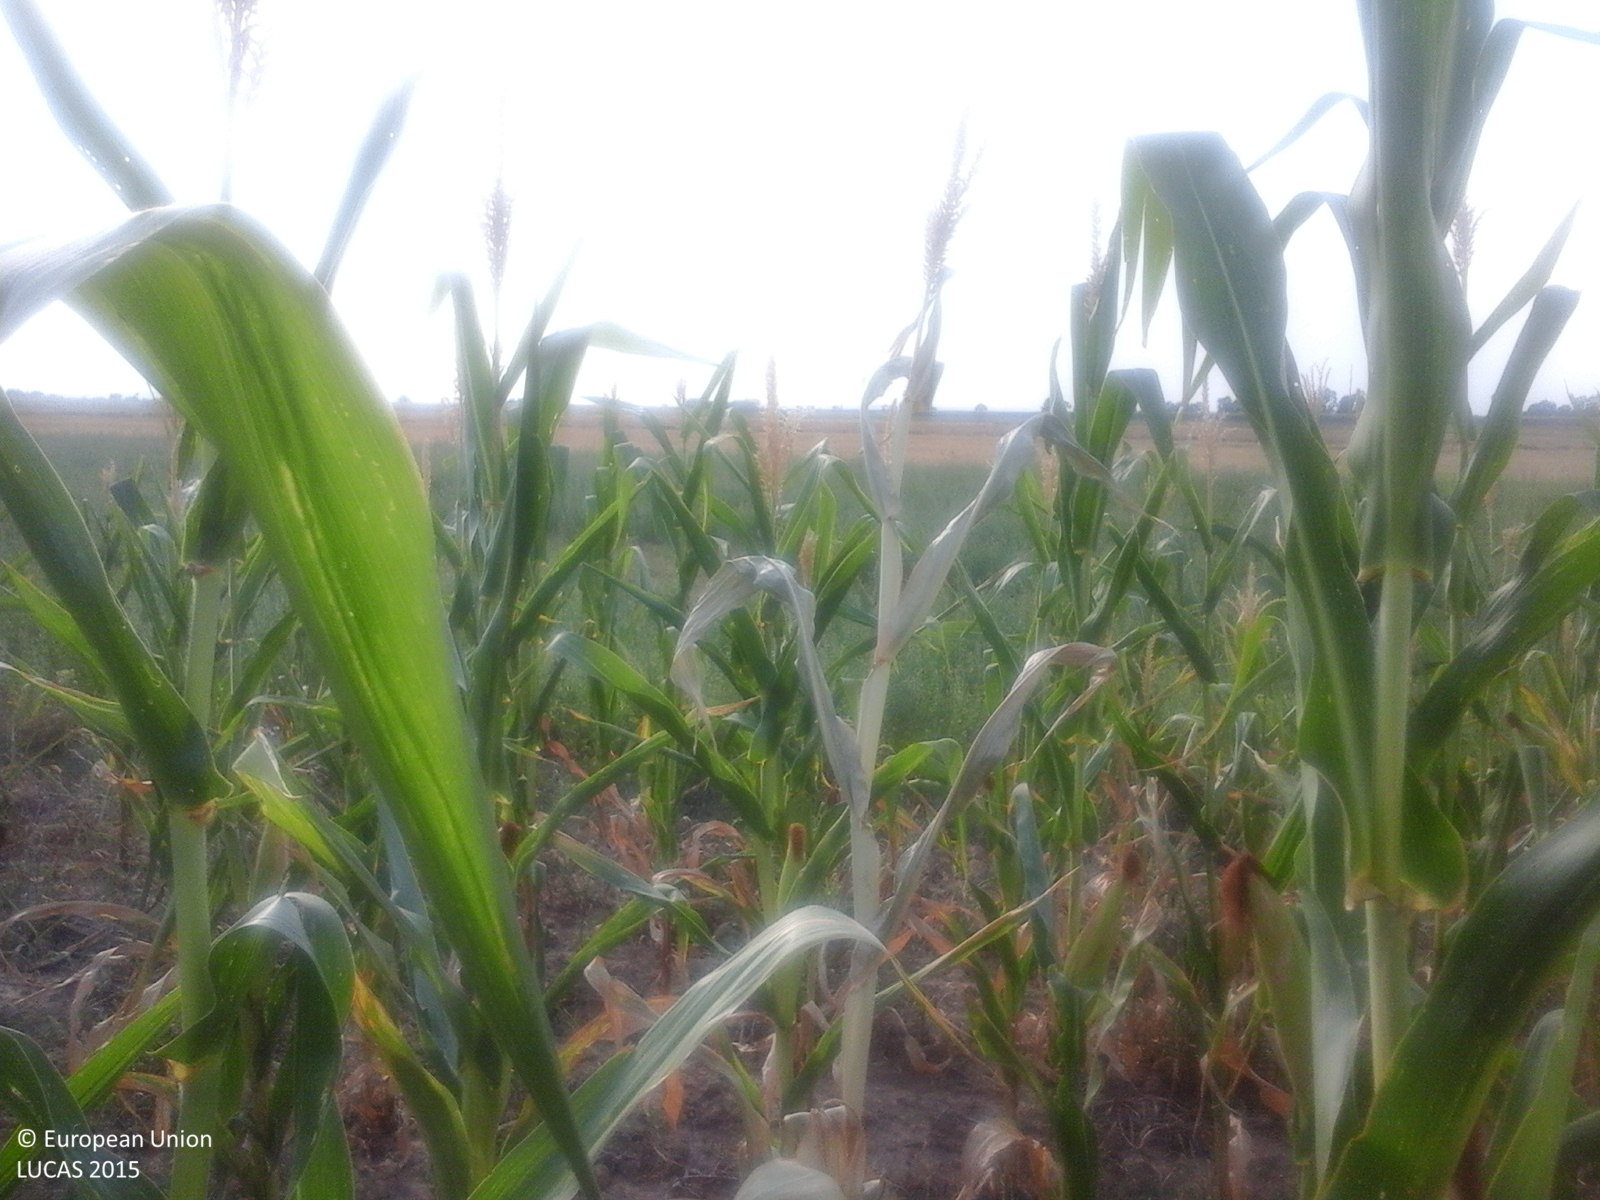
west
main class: Cropland
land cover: Maize
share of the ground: > 75 %
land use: Agriculture (excluding fallow land and kitchen gardens)
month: August
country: RO
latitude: 44.2417
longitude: 22.6987
